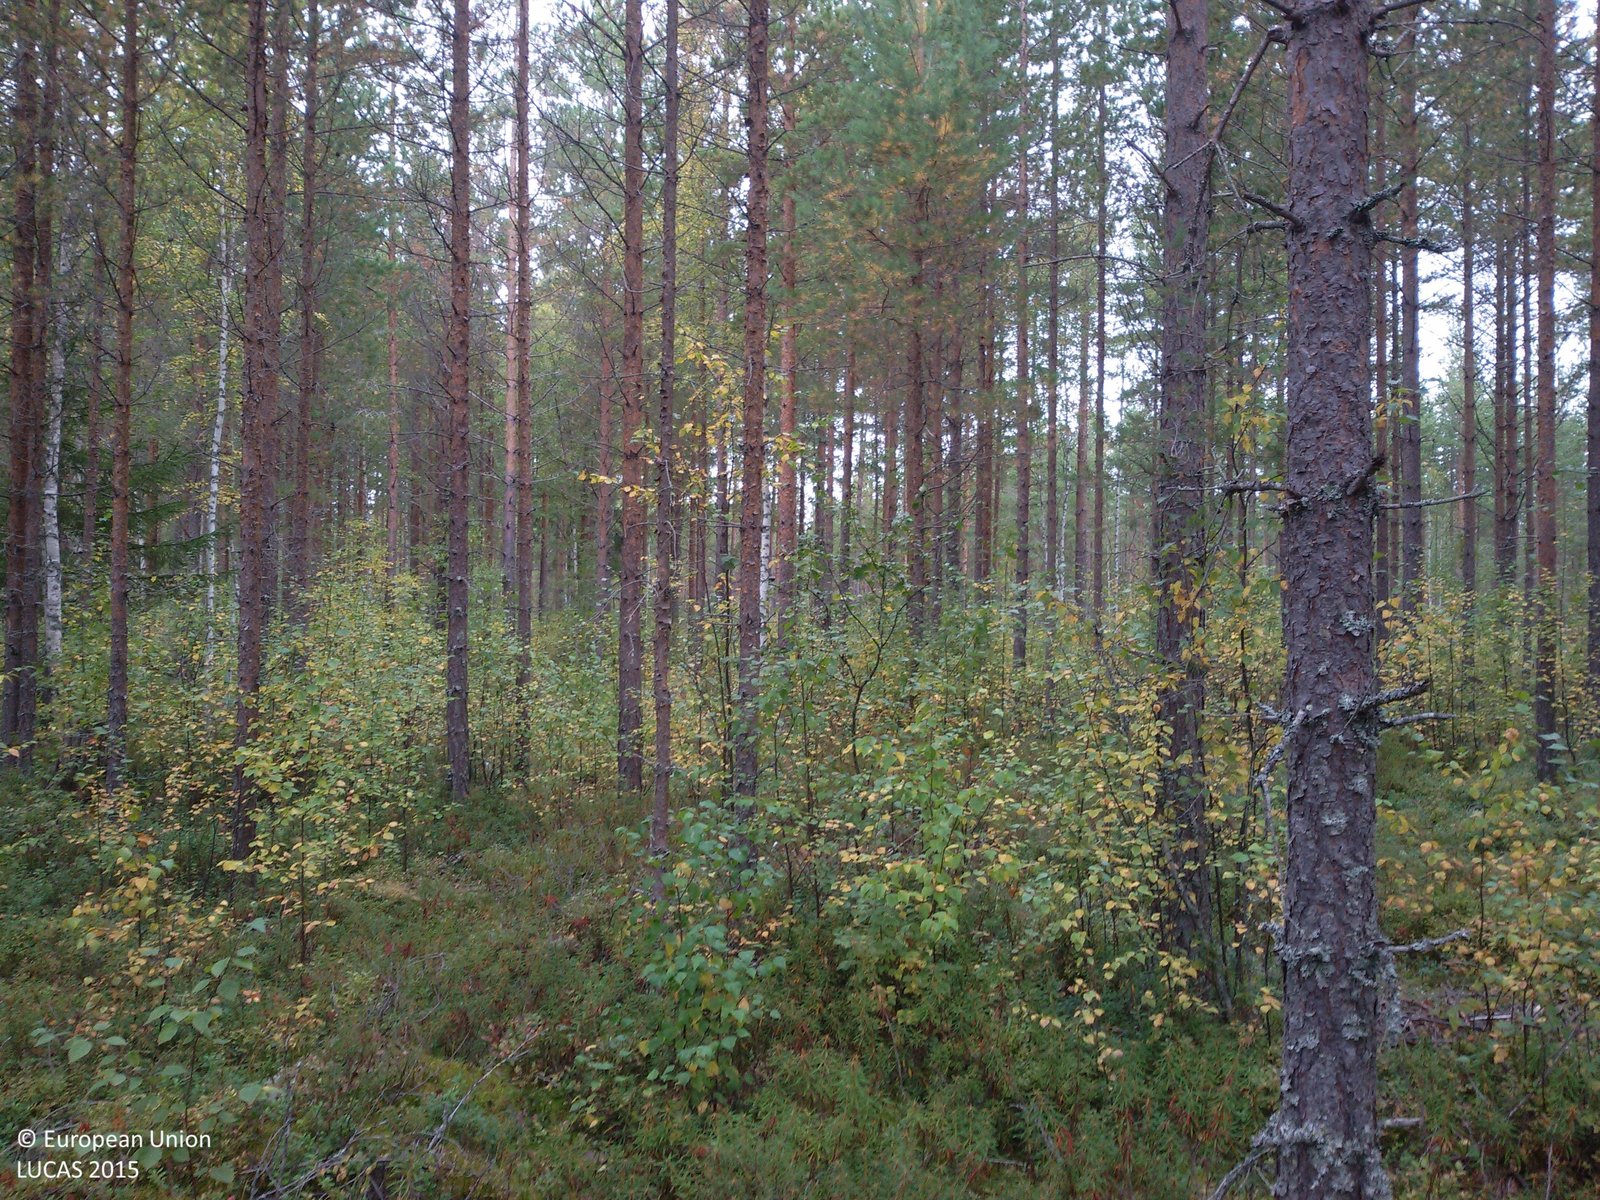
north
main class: Woodland
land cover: Pine dominated coniferous woodland
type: boreal forest
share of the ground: > 75 %
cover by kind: coniferous forest trees 75 %, shrubs 15 %, lichens and mosses 10 %
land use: Forestry
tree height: > 5 m
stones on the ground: 10 - 25 %
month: September
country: SE
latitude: 60.8020
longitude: 14.8200
